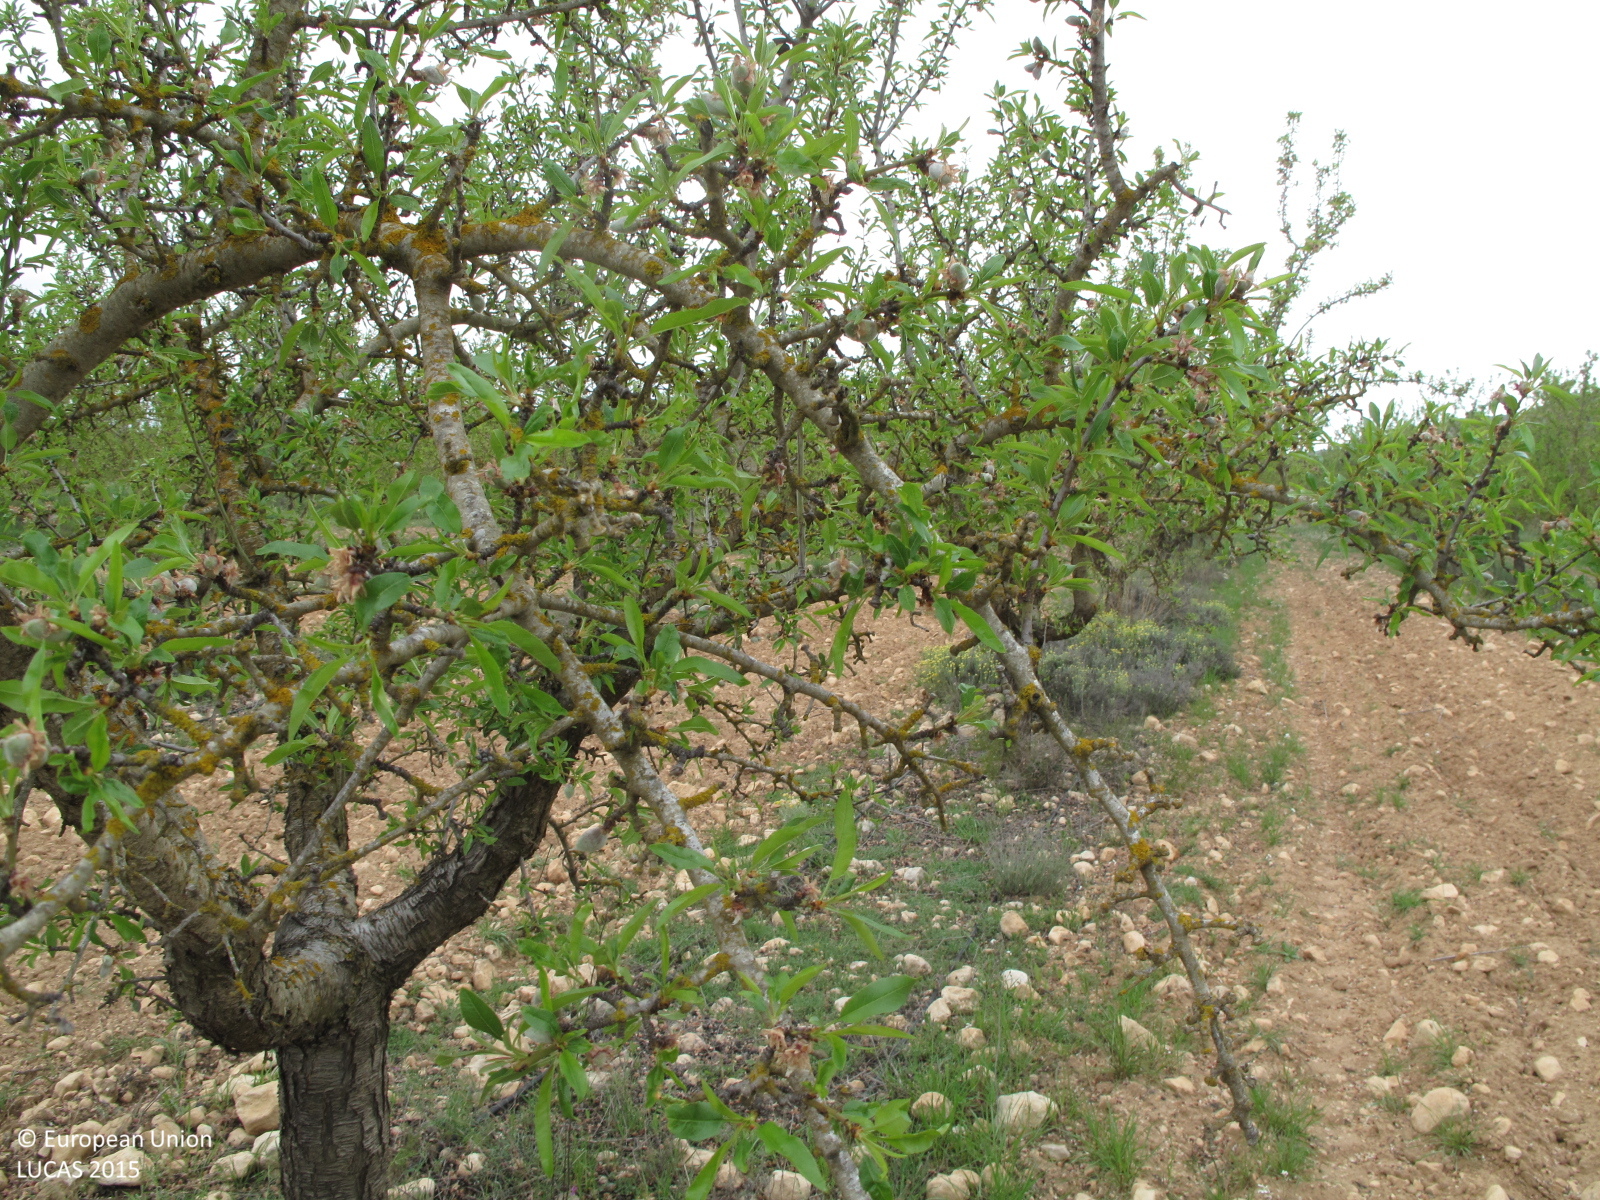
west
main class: Cropland
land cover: Nuts trees
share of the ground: 50 - 75 %
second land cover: Grassland without tree/shrub cover
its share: 25 - 50 %
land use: Agriculture (excluding fallow land and kitchen gardens)
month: April
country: ES
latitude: 38.5752
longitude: -0.9518
